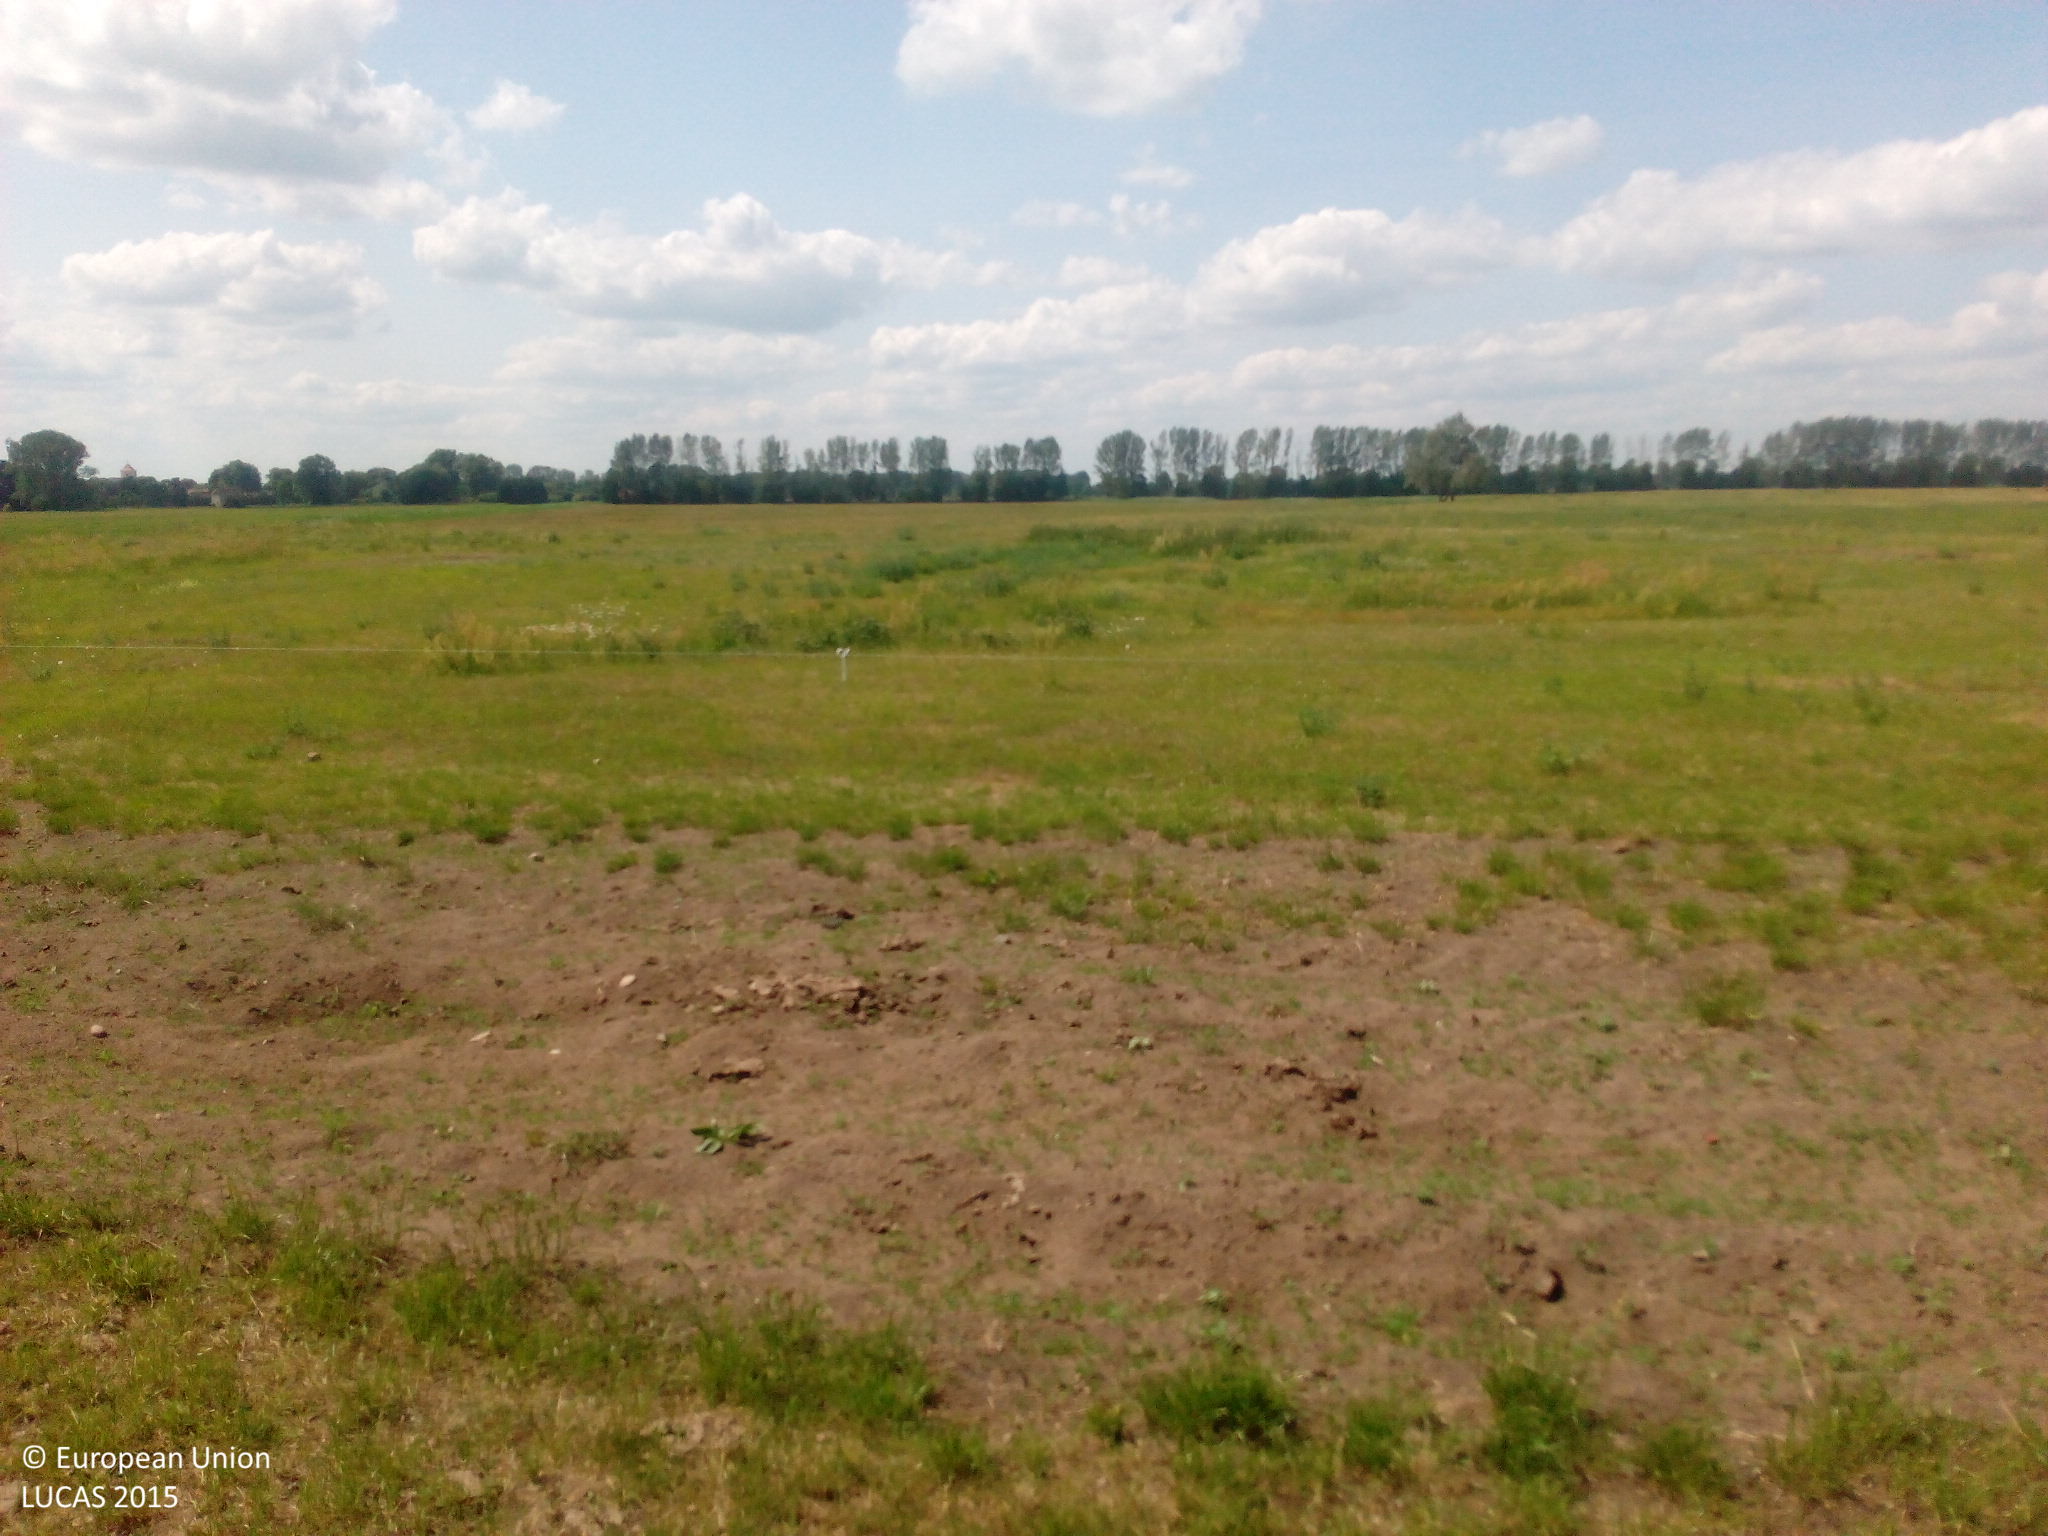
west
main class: Grassland
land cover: Grassland without tree/shrub cover
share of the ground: > 75 %
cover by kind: herbaceous plants 100 %
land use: Agriculture (excluding fallow land and kitchen gardens)
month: July
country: DE
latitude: 52.7448
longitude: 12.5919
